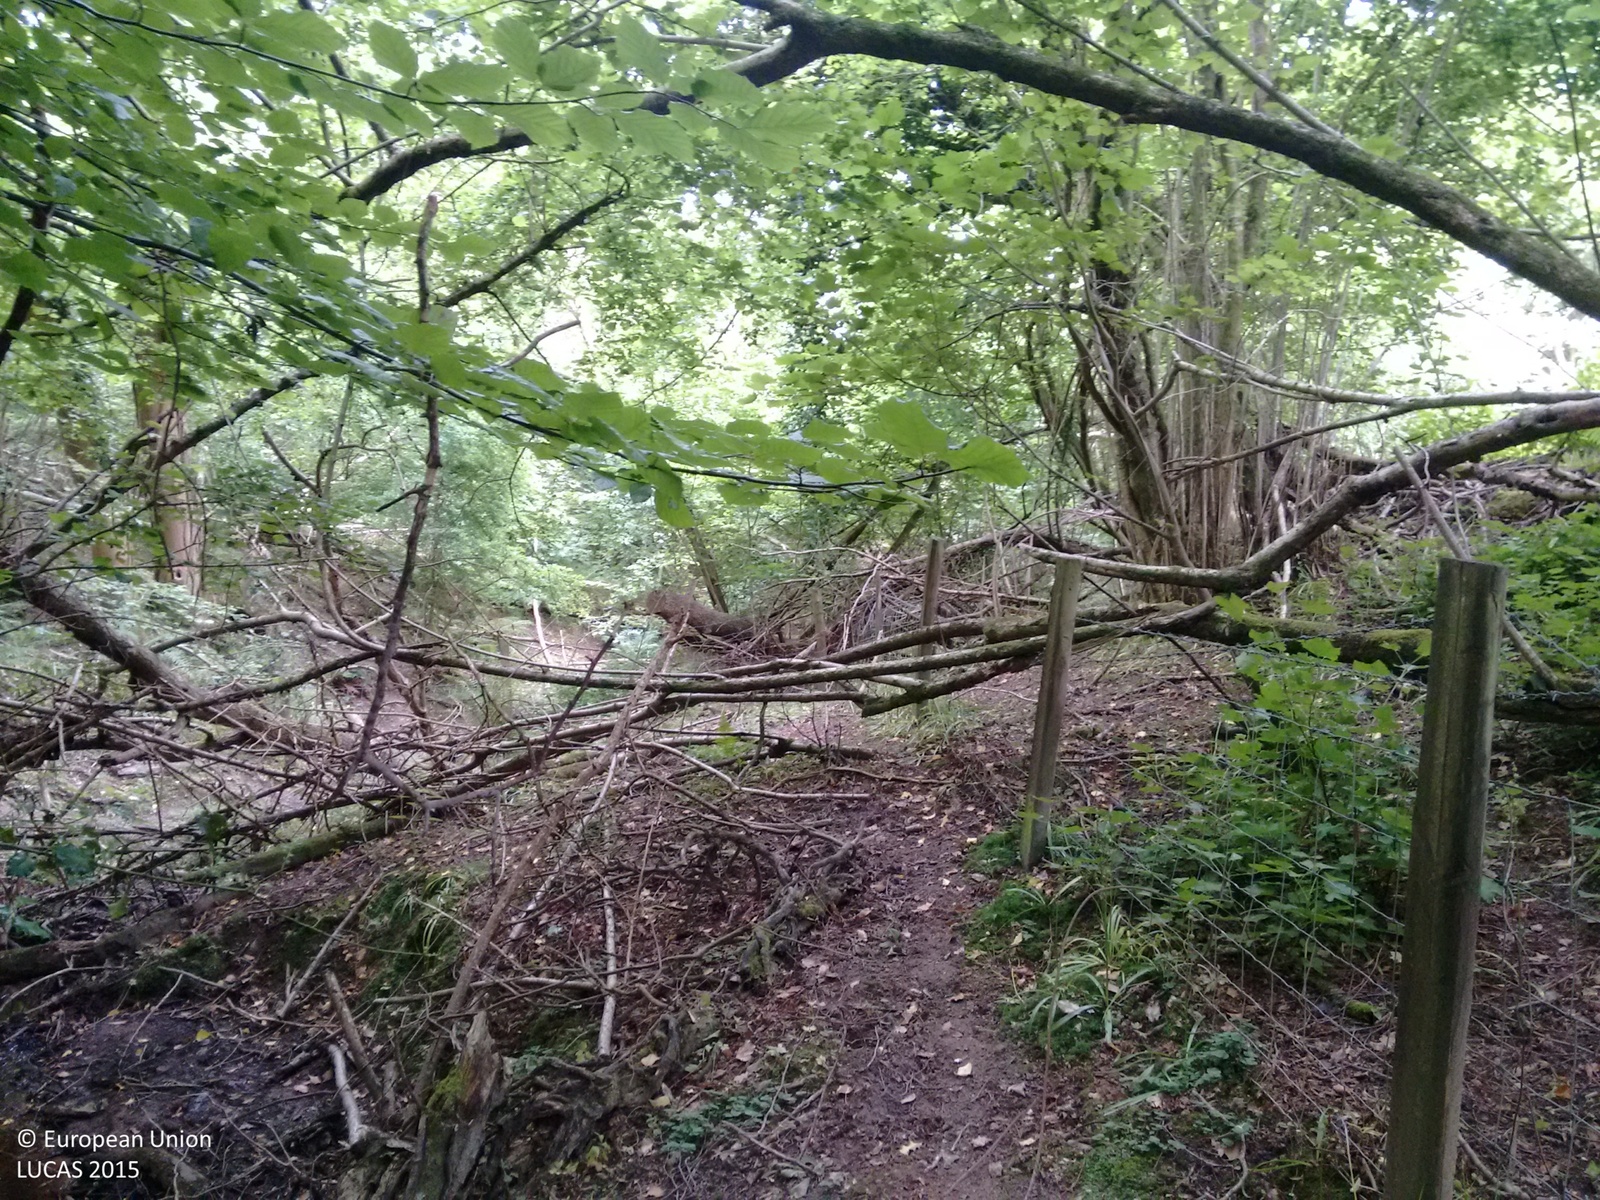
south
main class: Woodland
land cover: Broadleaved woodland
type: mesophytic deciduous forest
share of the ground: > 75 %
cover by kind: broadleaved forest trees 90 %, shrubs 10 %
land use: Forestry
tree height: > 5 m
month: June
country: GB
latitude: 50.9913
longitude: 0.1814
